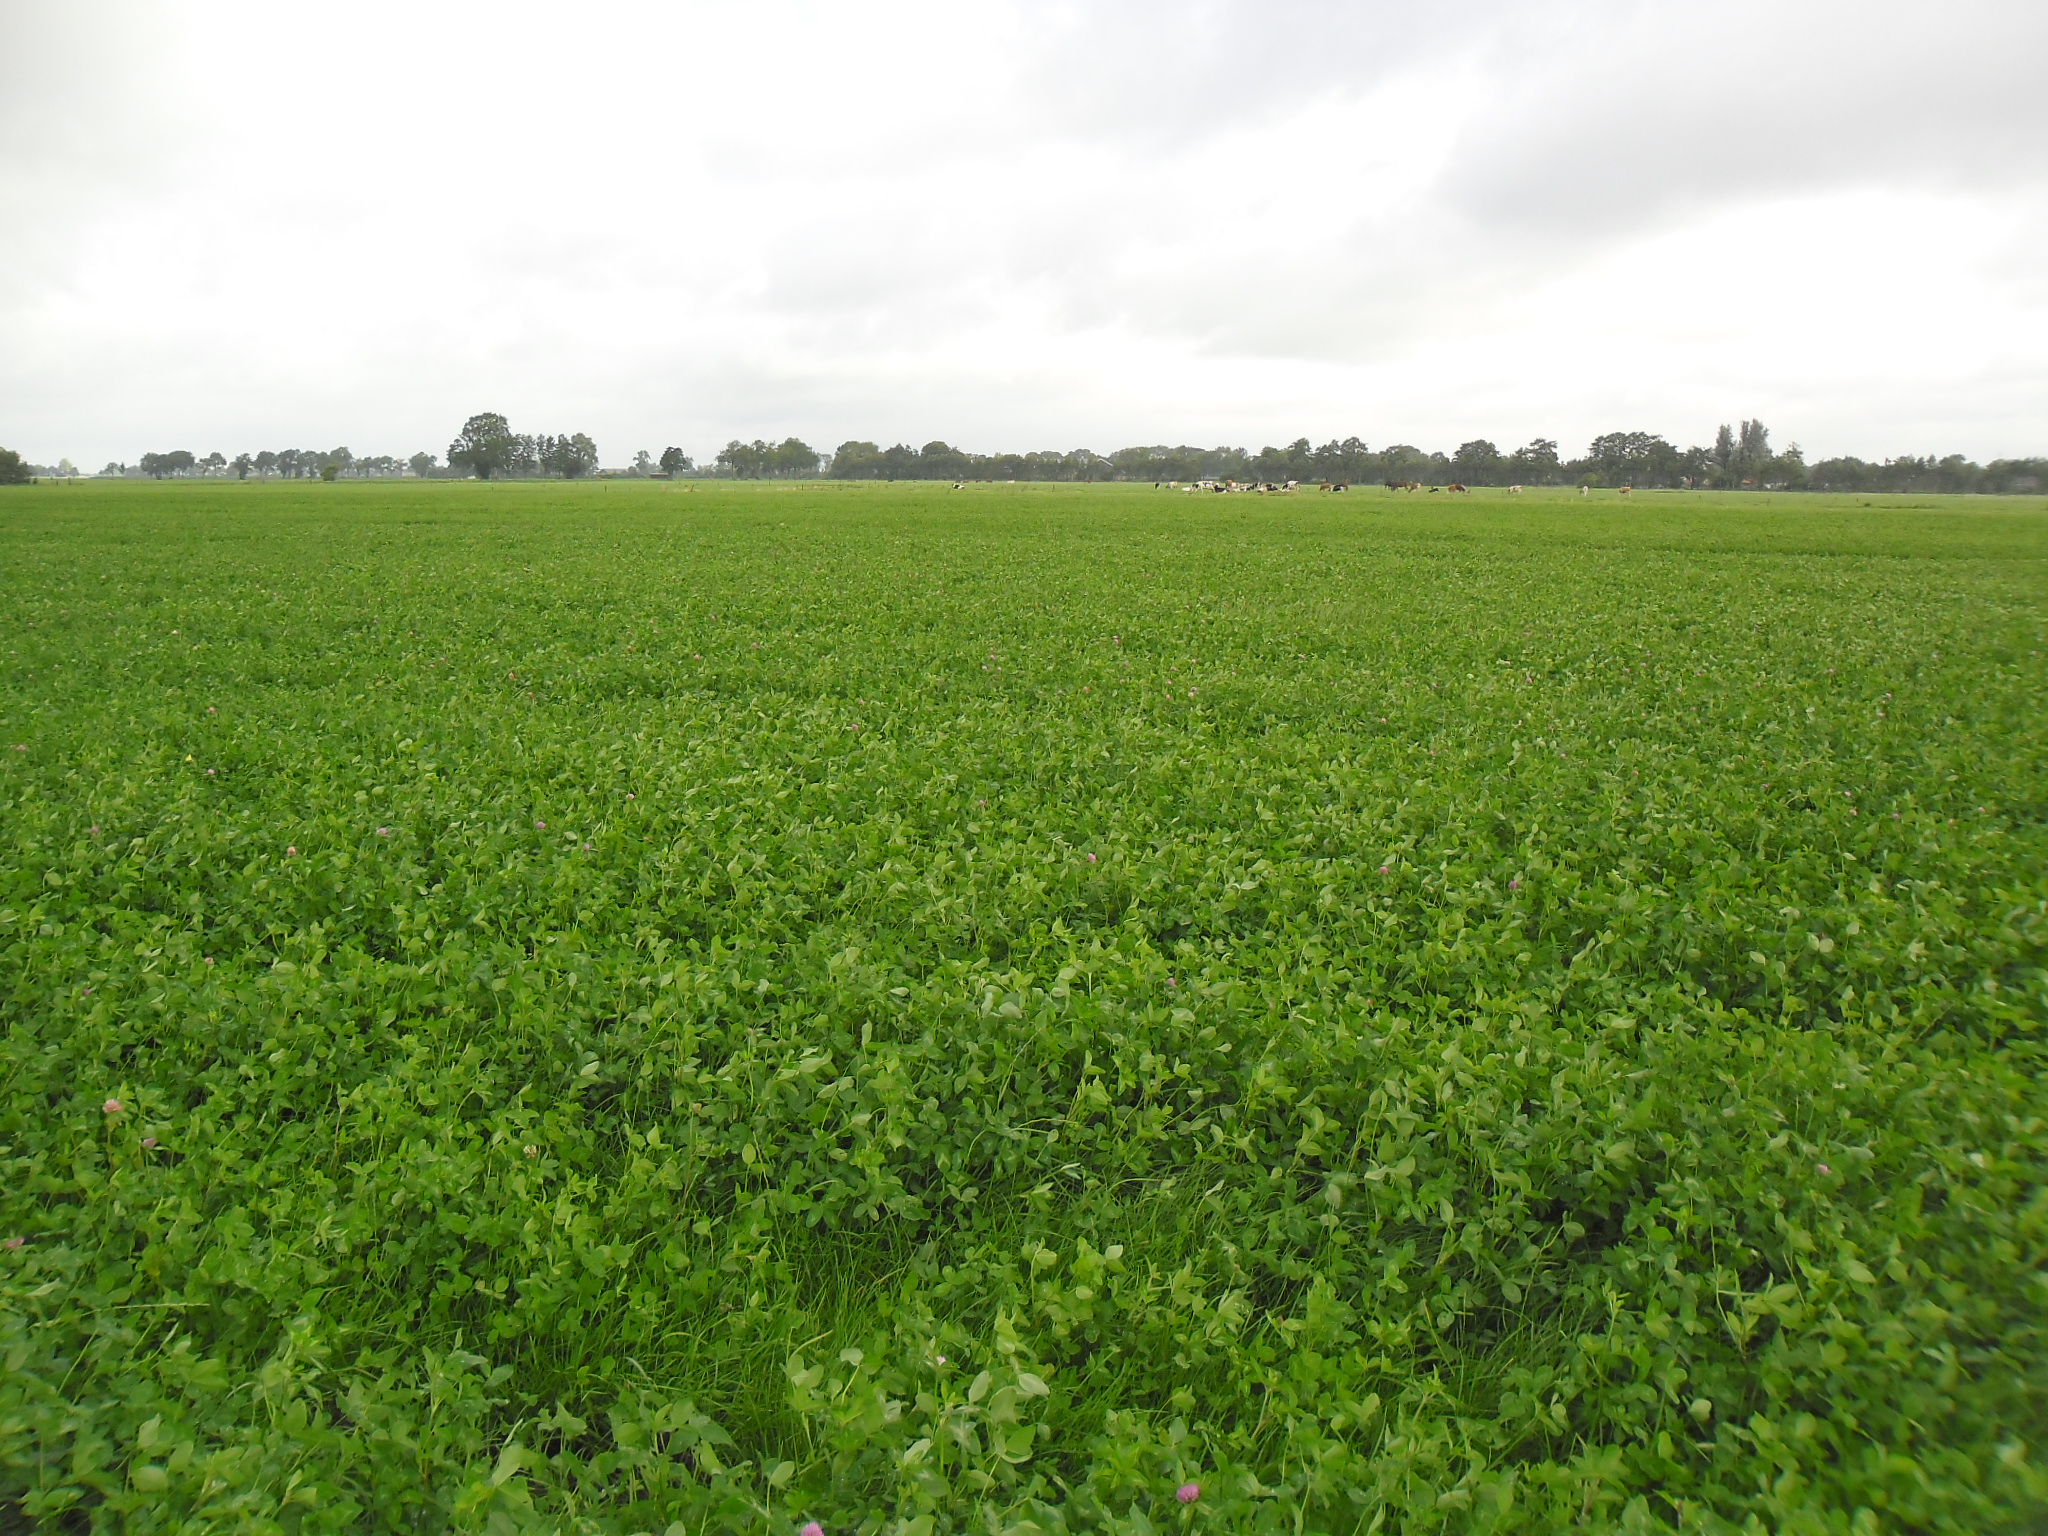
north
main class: Cropland
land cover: Other leguminous and mixtures for fodder
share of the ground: > 75 %
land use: Agriculture (excluding fallow land and kitchen gardens)
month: July
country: NL
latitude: 52.6218
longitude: 6.1736
